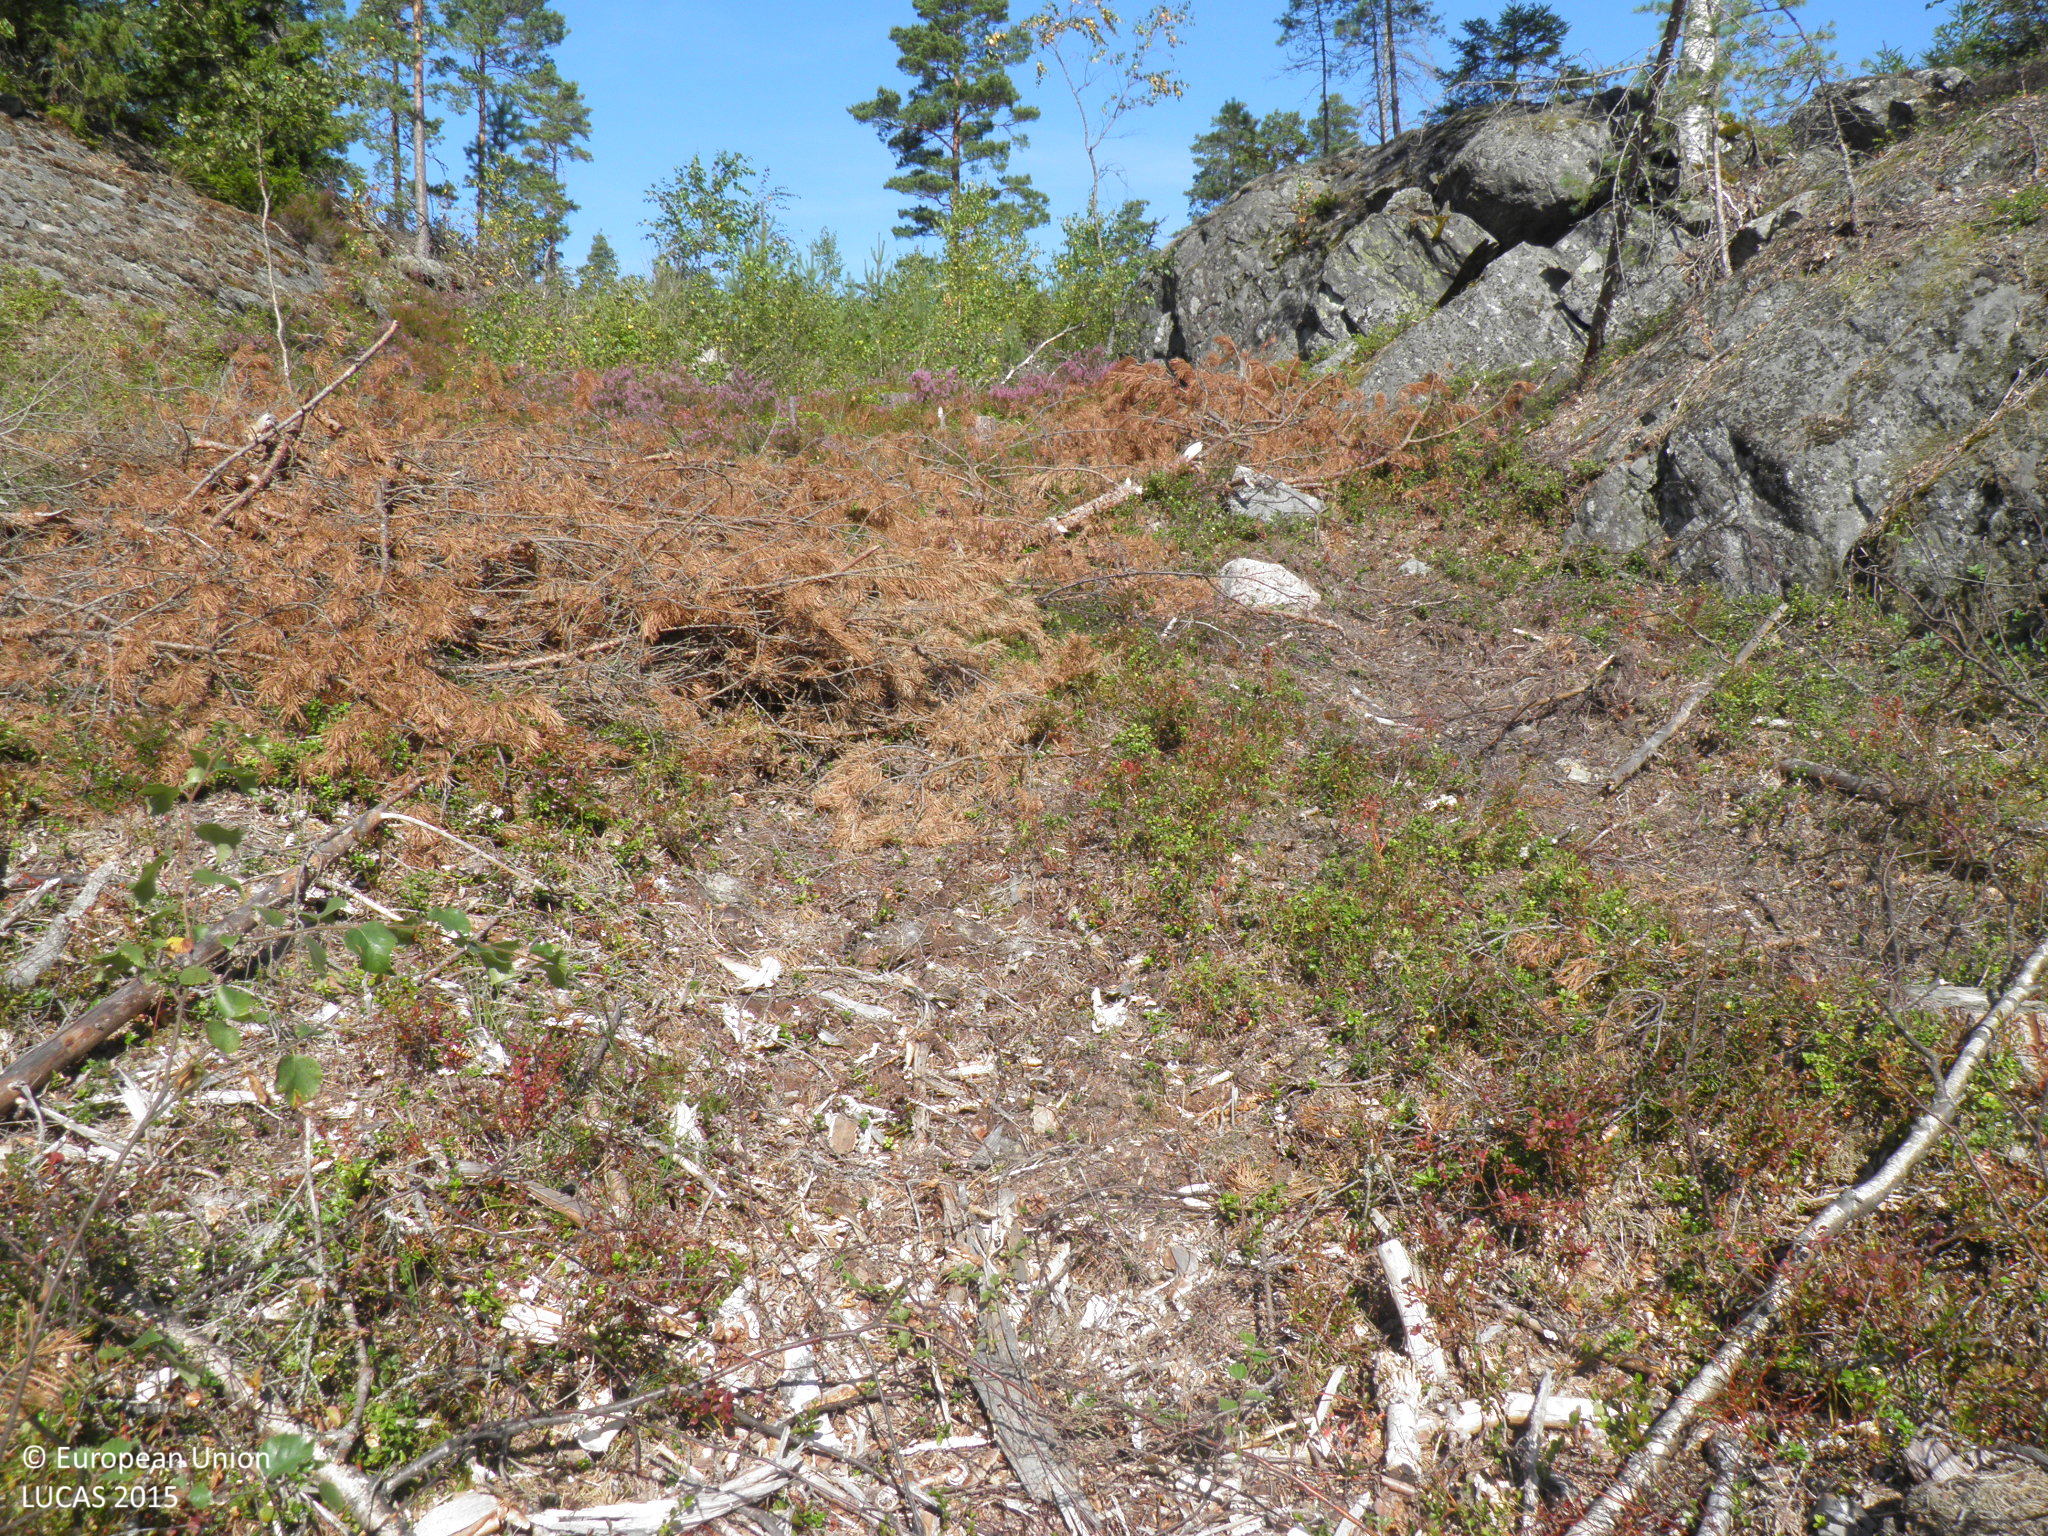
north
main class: Grassland
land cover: Spontaneously vegetated surfaces
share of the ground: 10 - 25 %
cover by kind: unconsolidated bare surface 50 %, consolidated bare surface 15 %, herbaceous plants 10 %, shrubs 5 %
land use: Forestry
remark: Clear cut
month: August
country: FI
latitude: 60.0568
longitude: 22.7392
